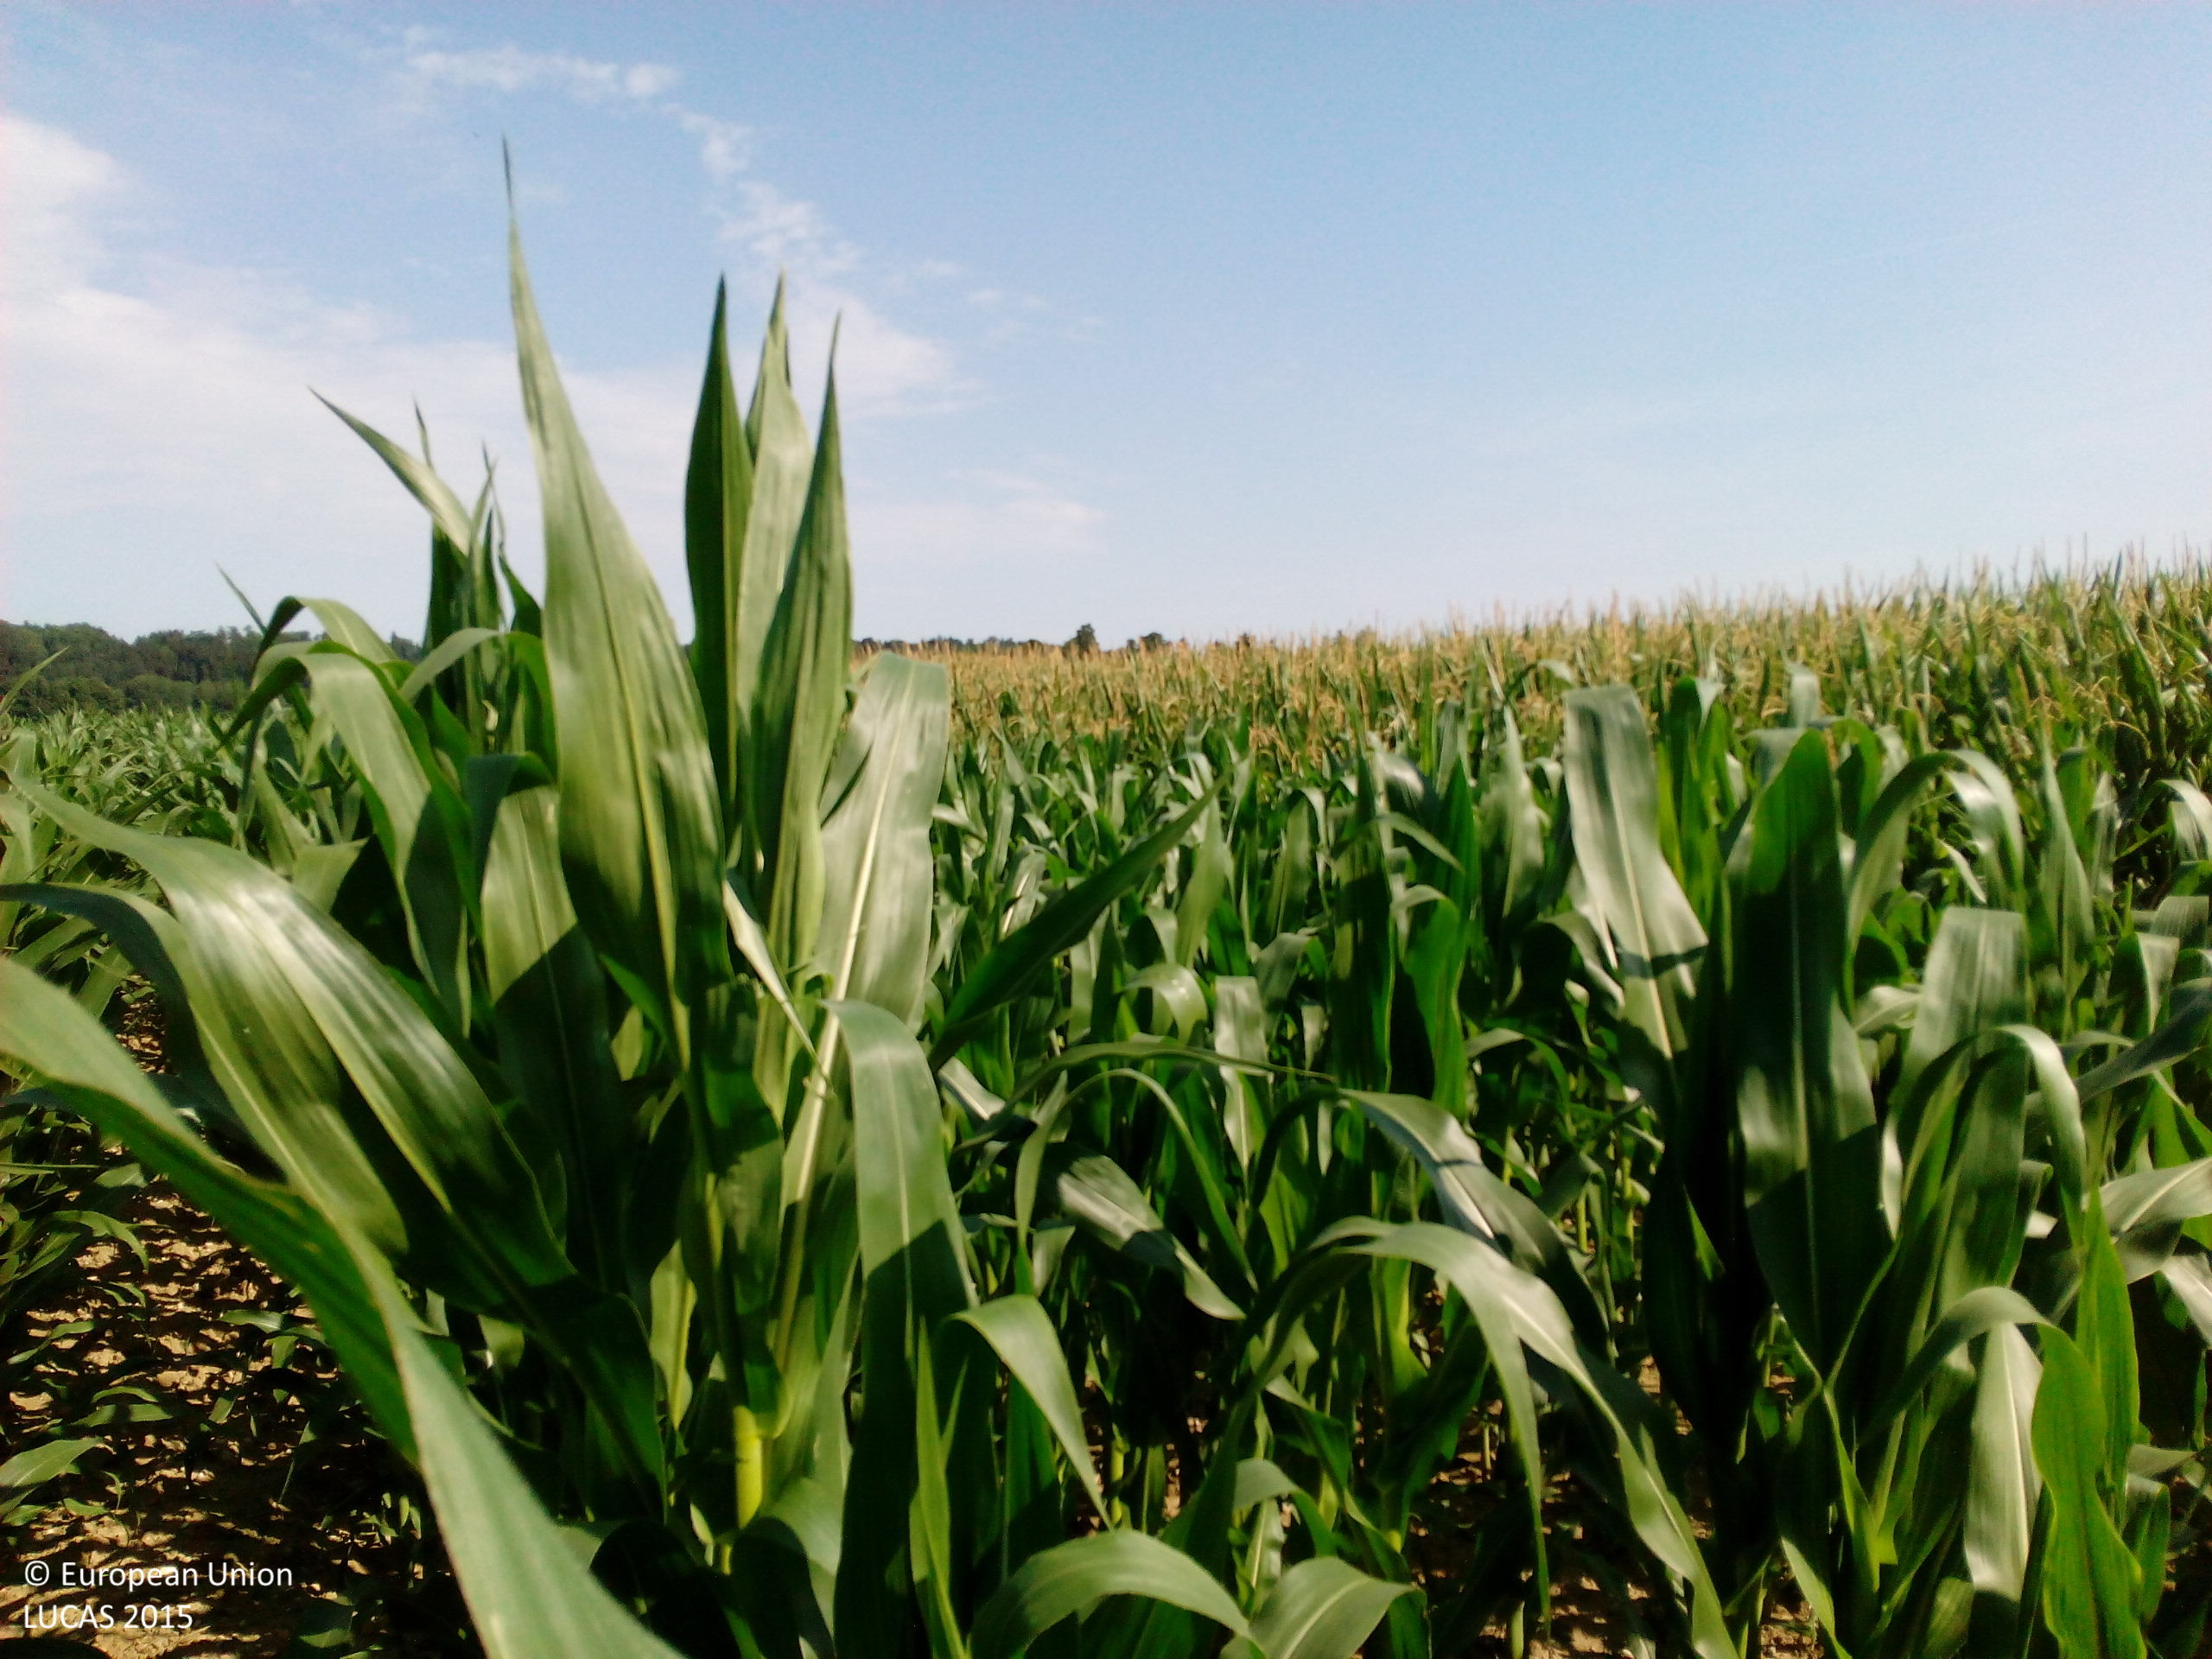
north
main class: Cropland
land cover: Maize
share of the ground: > 75 %
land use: Agriculture (excluding fallow land and kitchen gardens)
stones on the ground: < 10 %
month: July
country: DE
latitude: 48.3205
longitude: 13.2224
